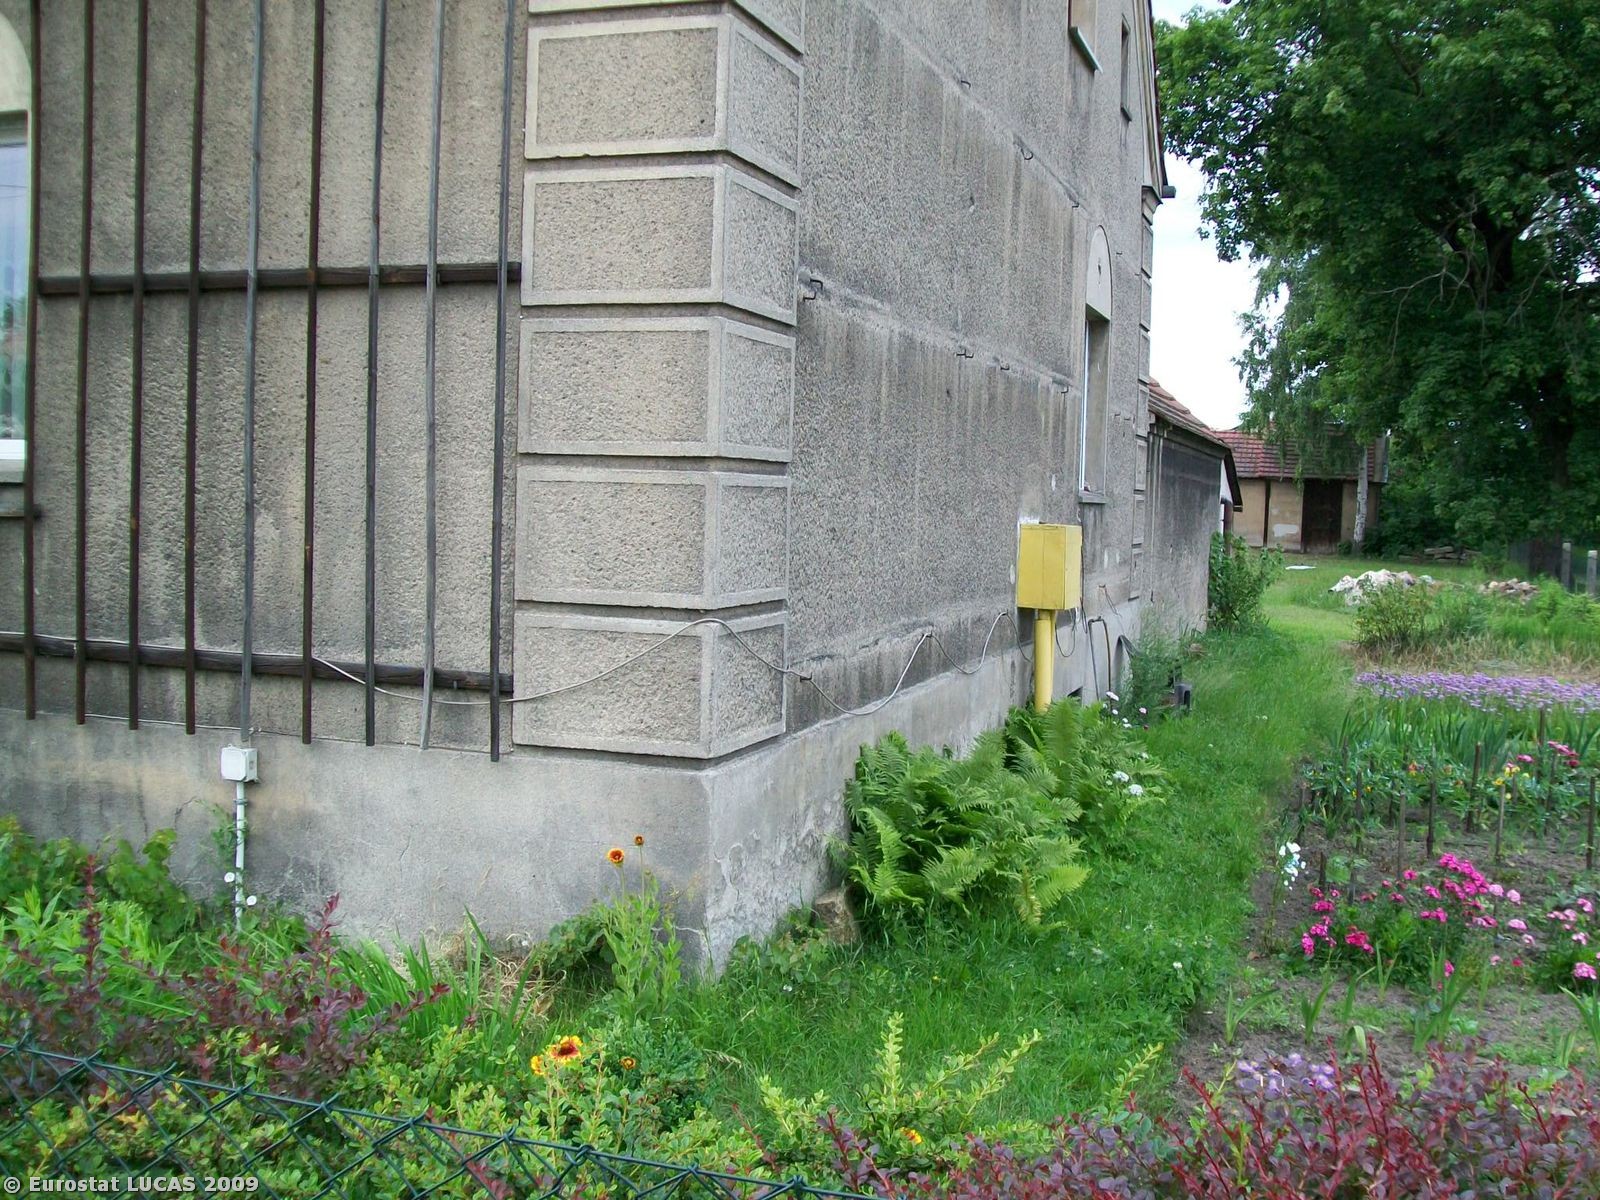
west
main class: Cropland
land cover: Floriculture and ornamental plants
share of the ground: > 75 %
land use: Kitchen garden
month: June
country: PL
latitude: 51.5068
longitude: 15.2046
